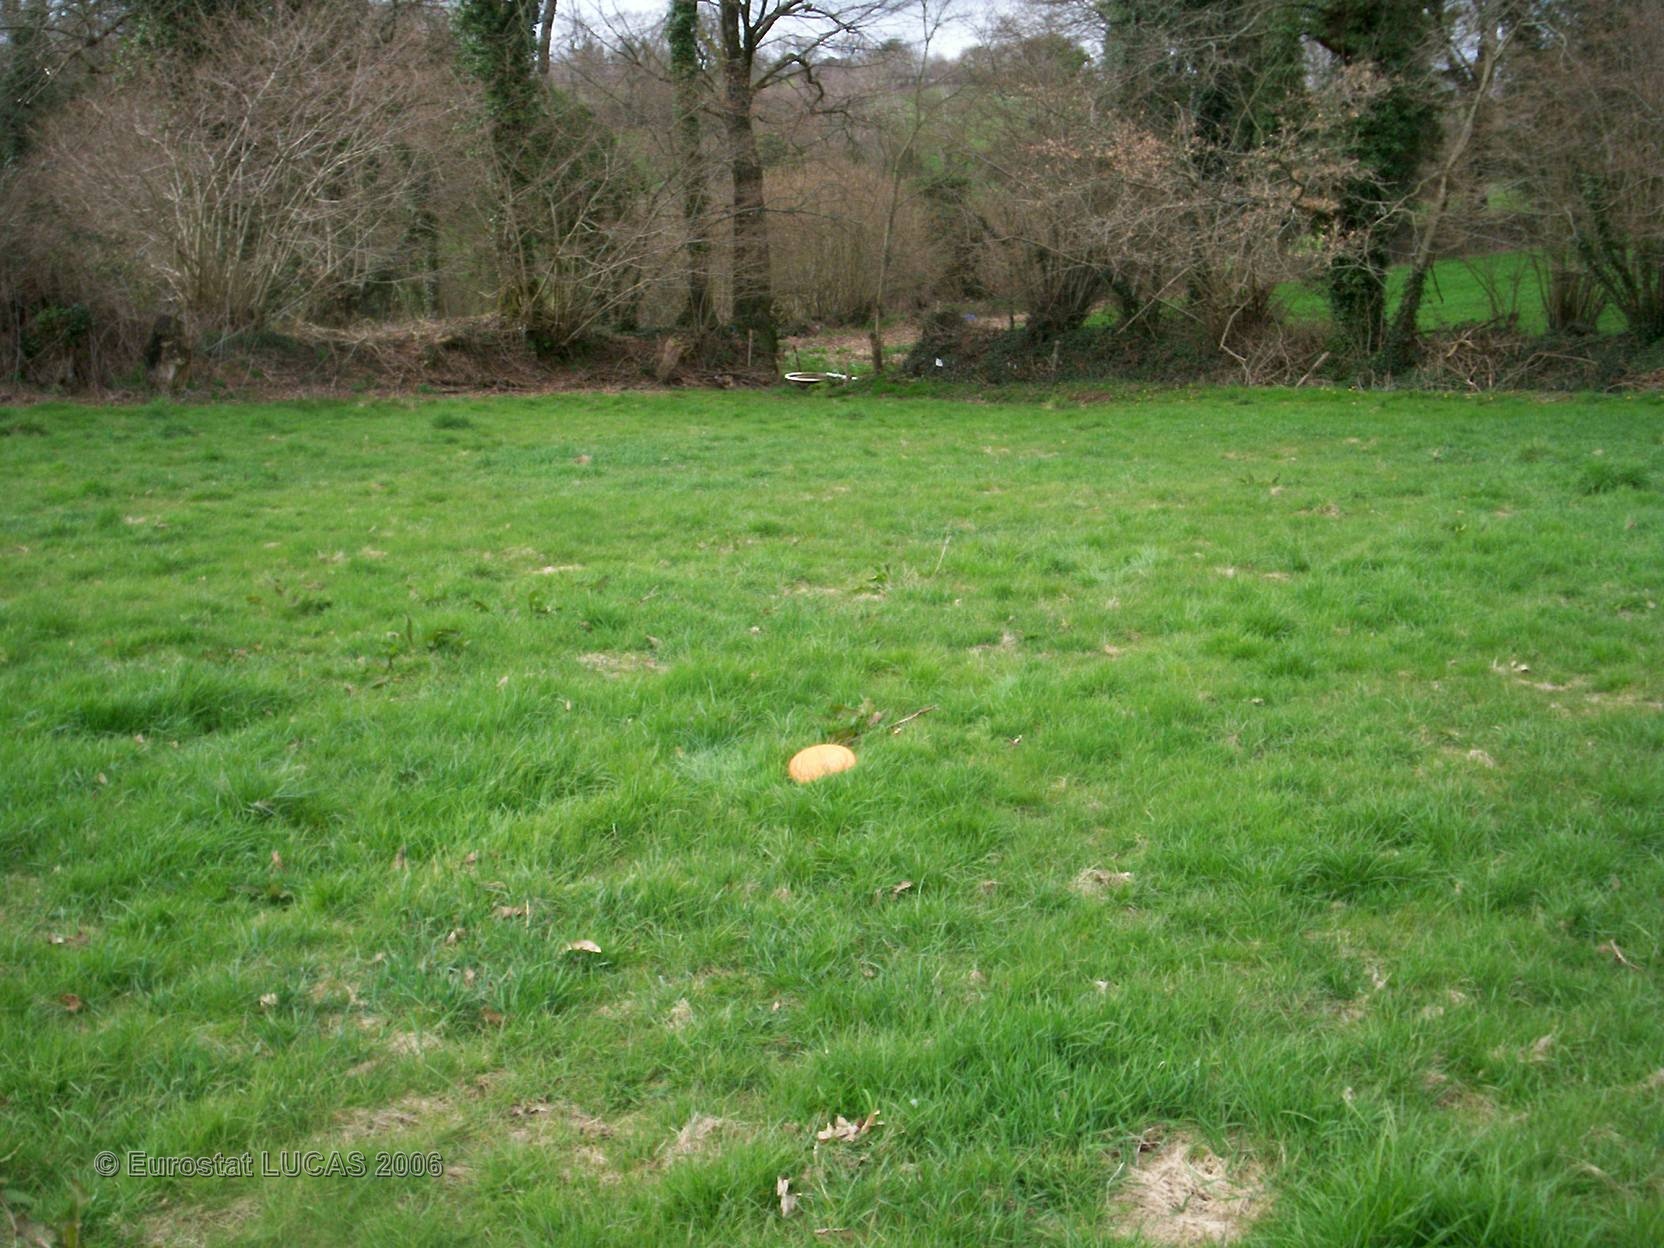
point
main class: Grassland
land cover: Grassland without tree/shrub cover
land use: Agriculture (excluding fallow land and kitchen gardens)
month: April
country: FR
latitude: 48.0667
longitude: -3.6198
